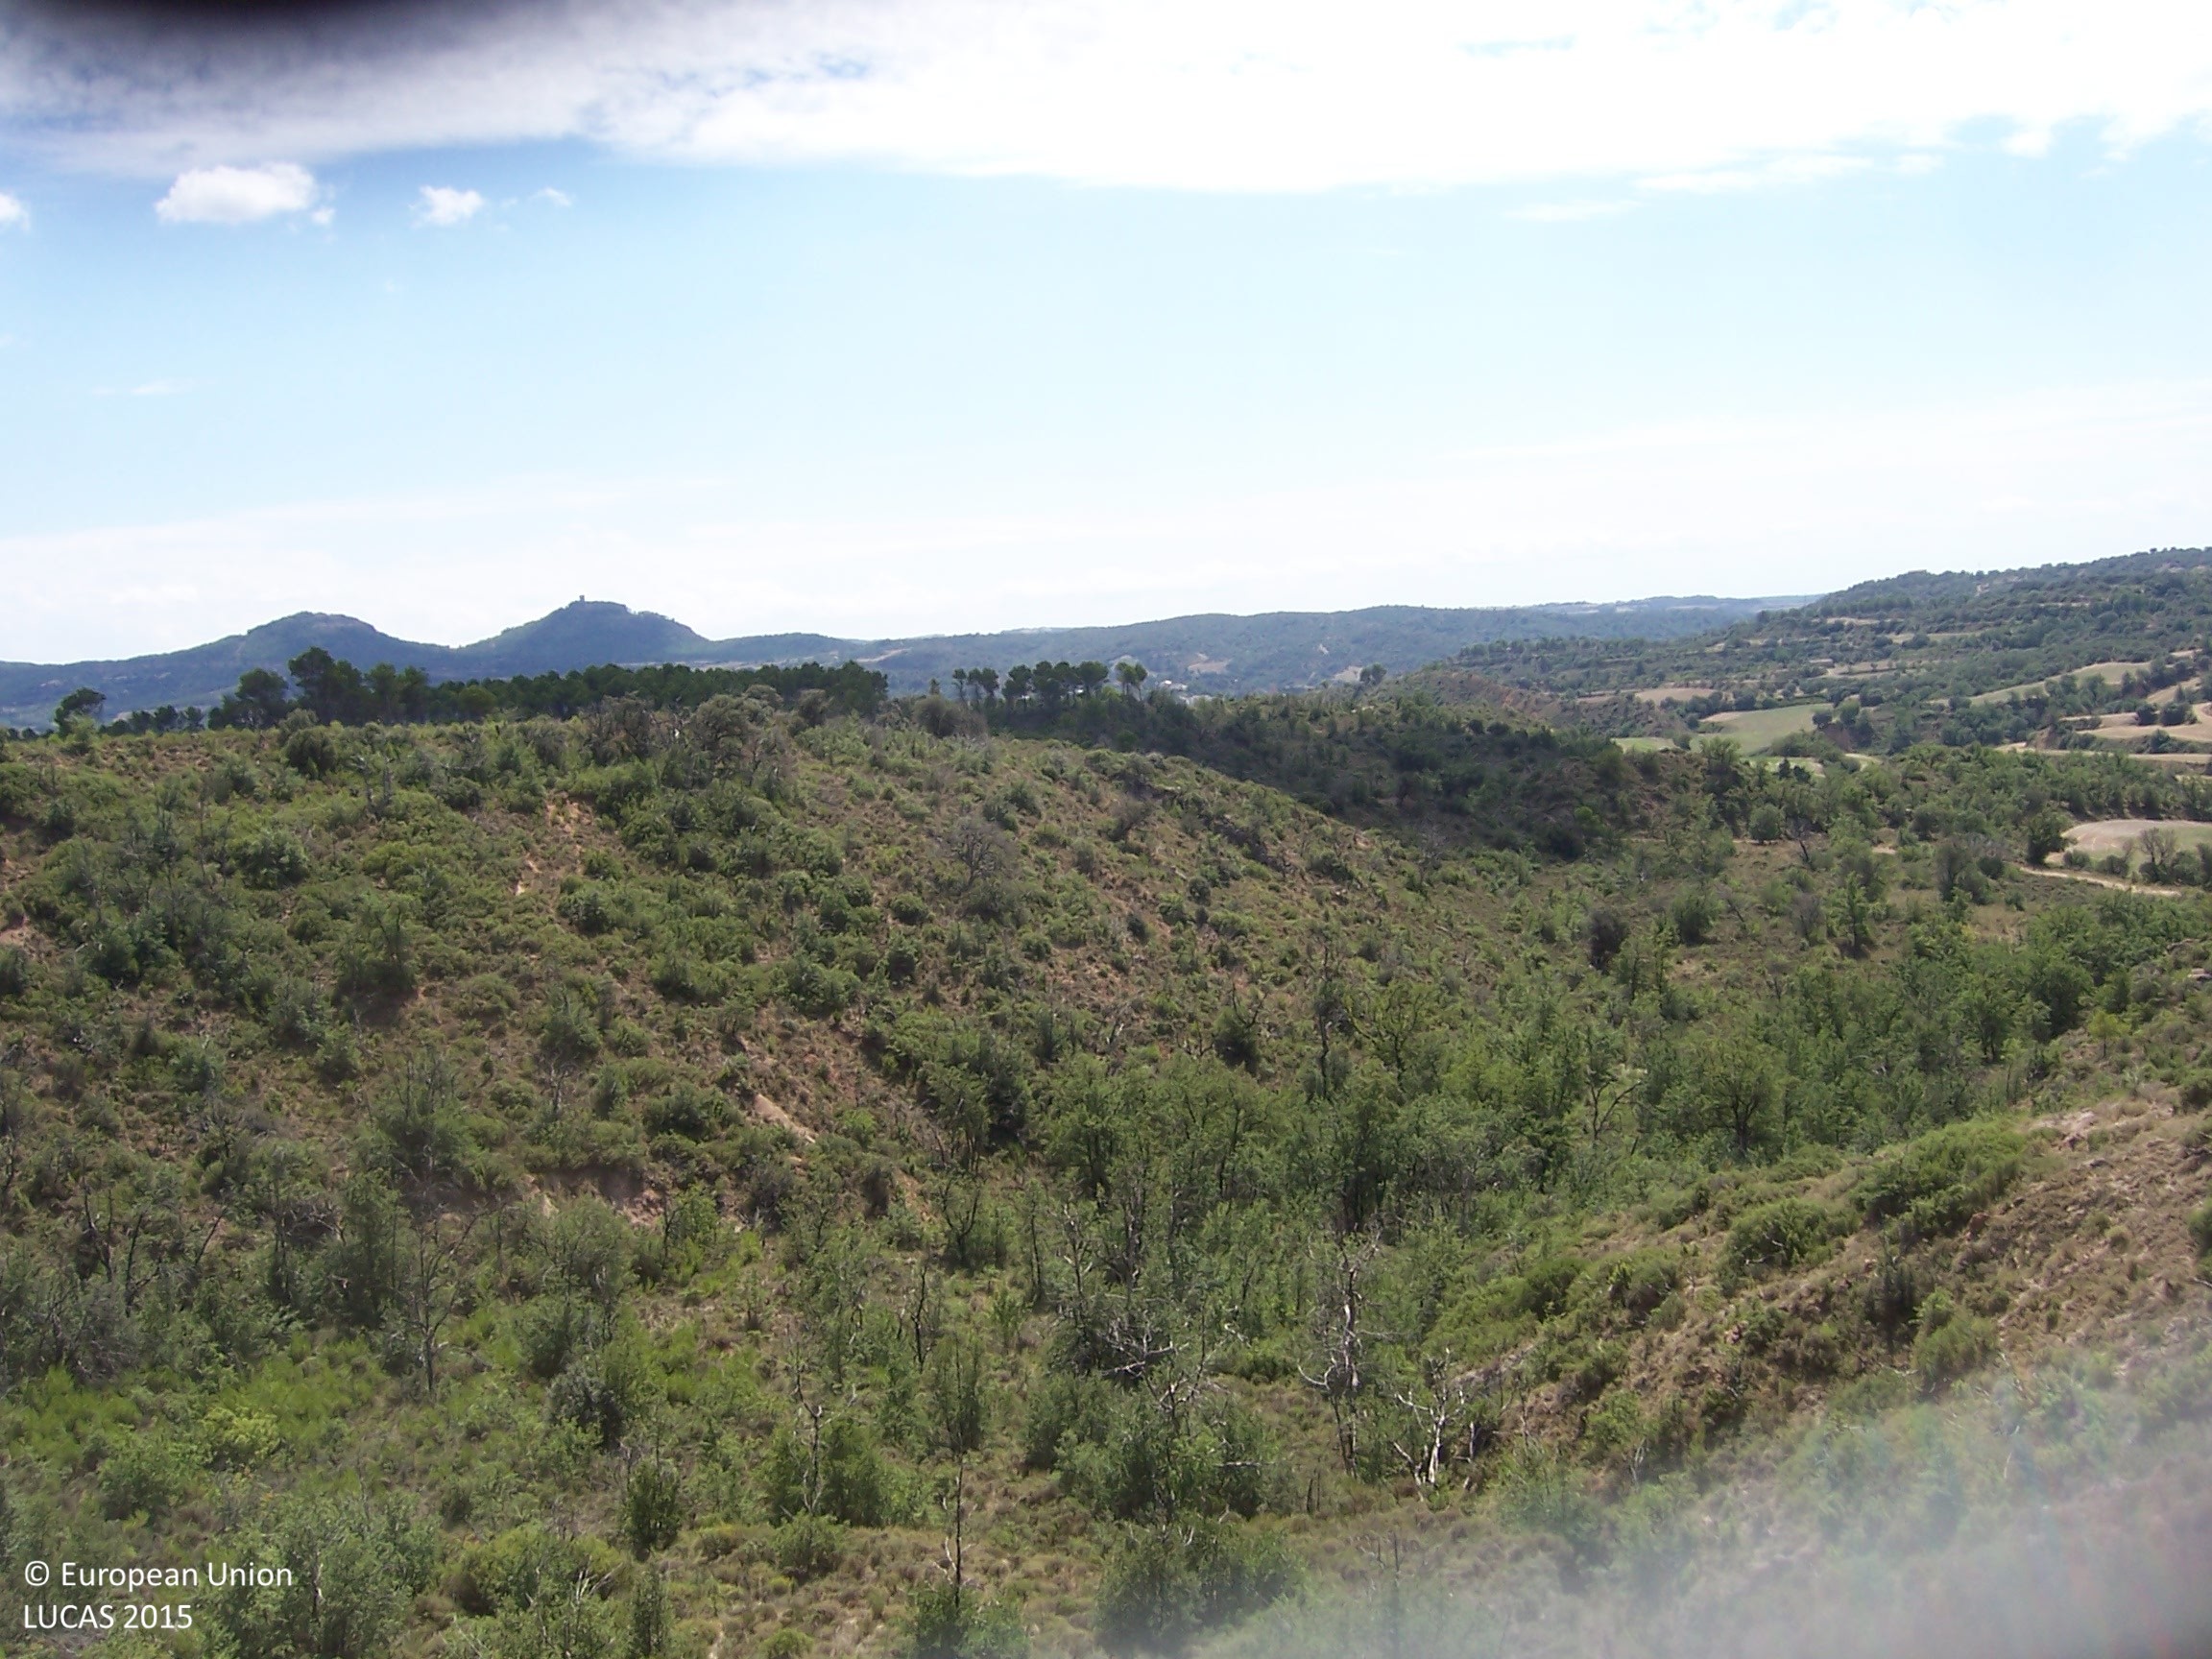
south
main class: Shrubland
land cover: Shrubland without tree cover
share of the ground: > 75 %
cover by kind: consolidated bare surface 50 %, unconsolidated bare surface 35 %, shrubs 15 %
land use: Semi-natural and natural areas not in use
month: August
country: ES
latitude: 42.0137
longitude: 0.3834
